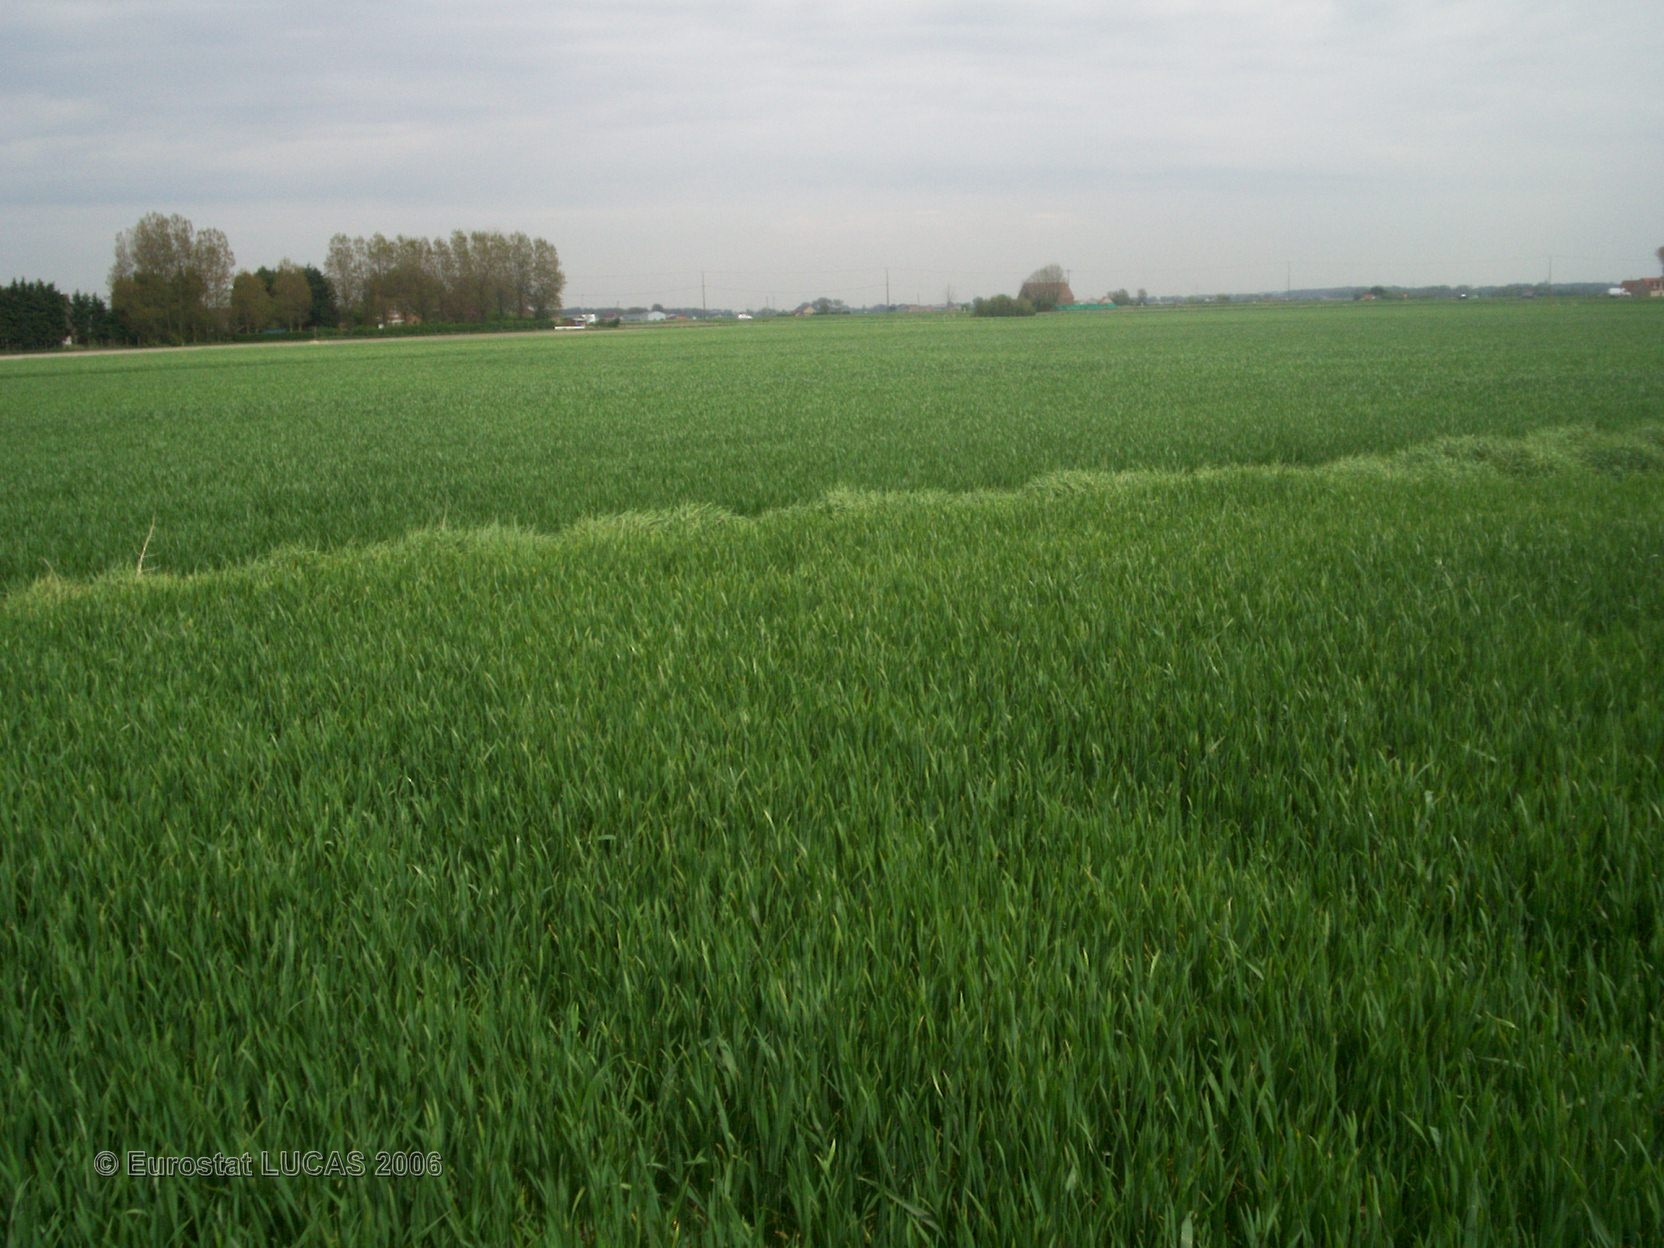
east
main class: Cropland
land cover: Common wheat
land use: Agriculture (excluding fallow land and kitchen gardens)
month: May
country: FR
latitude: 50.9739
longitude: 2.3385
